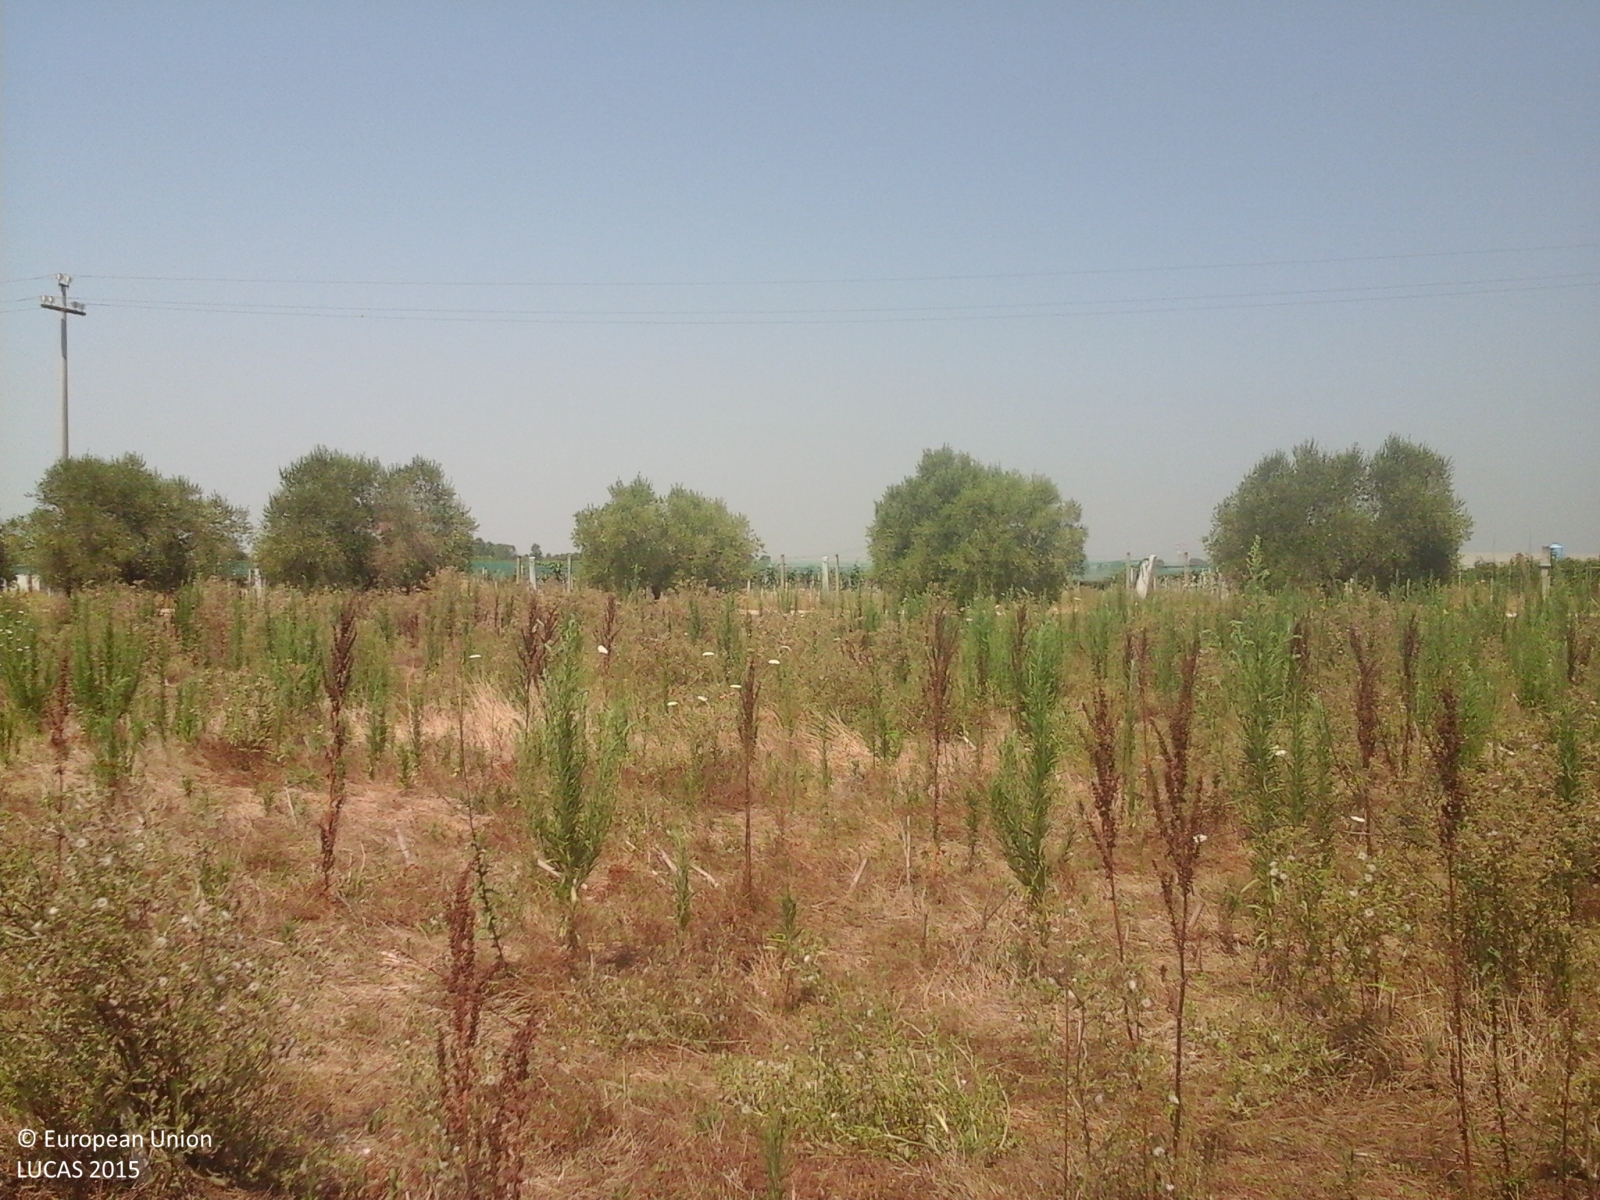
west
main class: Grassland
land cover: Grassland without tree/shrub cover
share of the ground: > 75 %
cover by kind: herbaceous plants 100 %
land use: Agriculture (excluding fallow land and kitchen gardens)
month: July
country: IT
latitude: 41.5866
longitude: 12.7362
